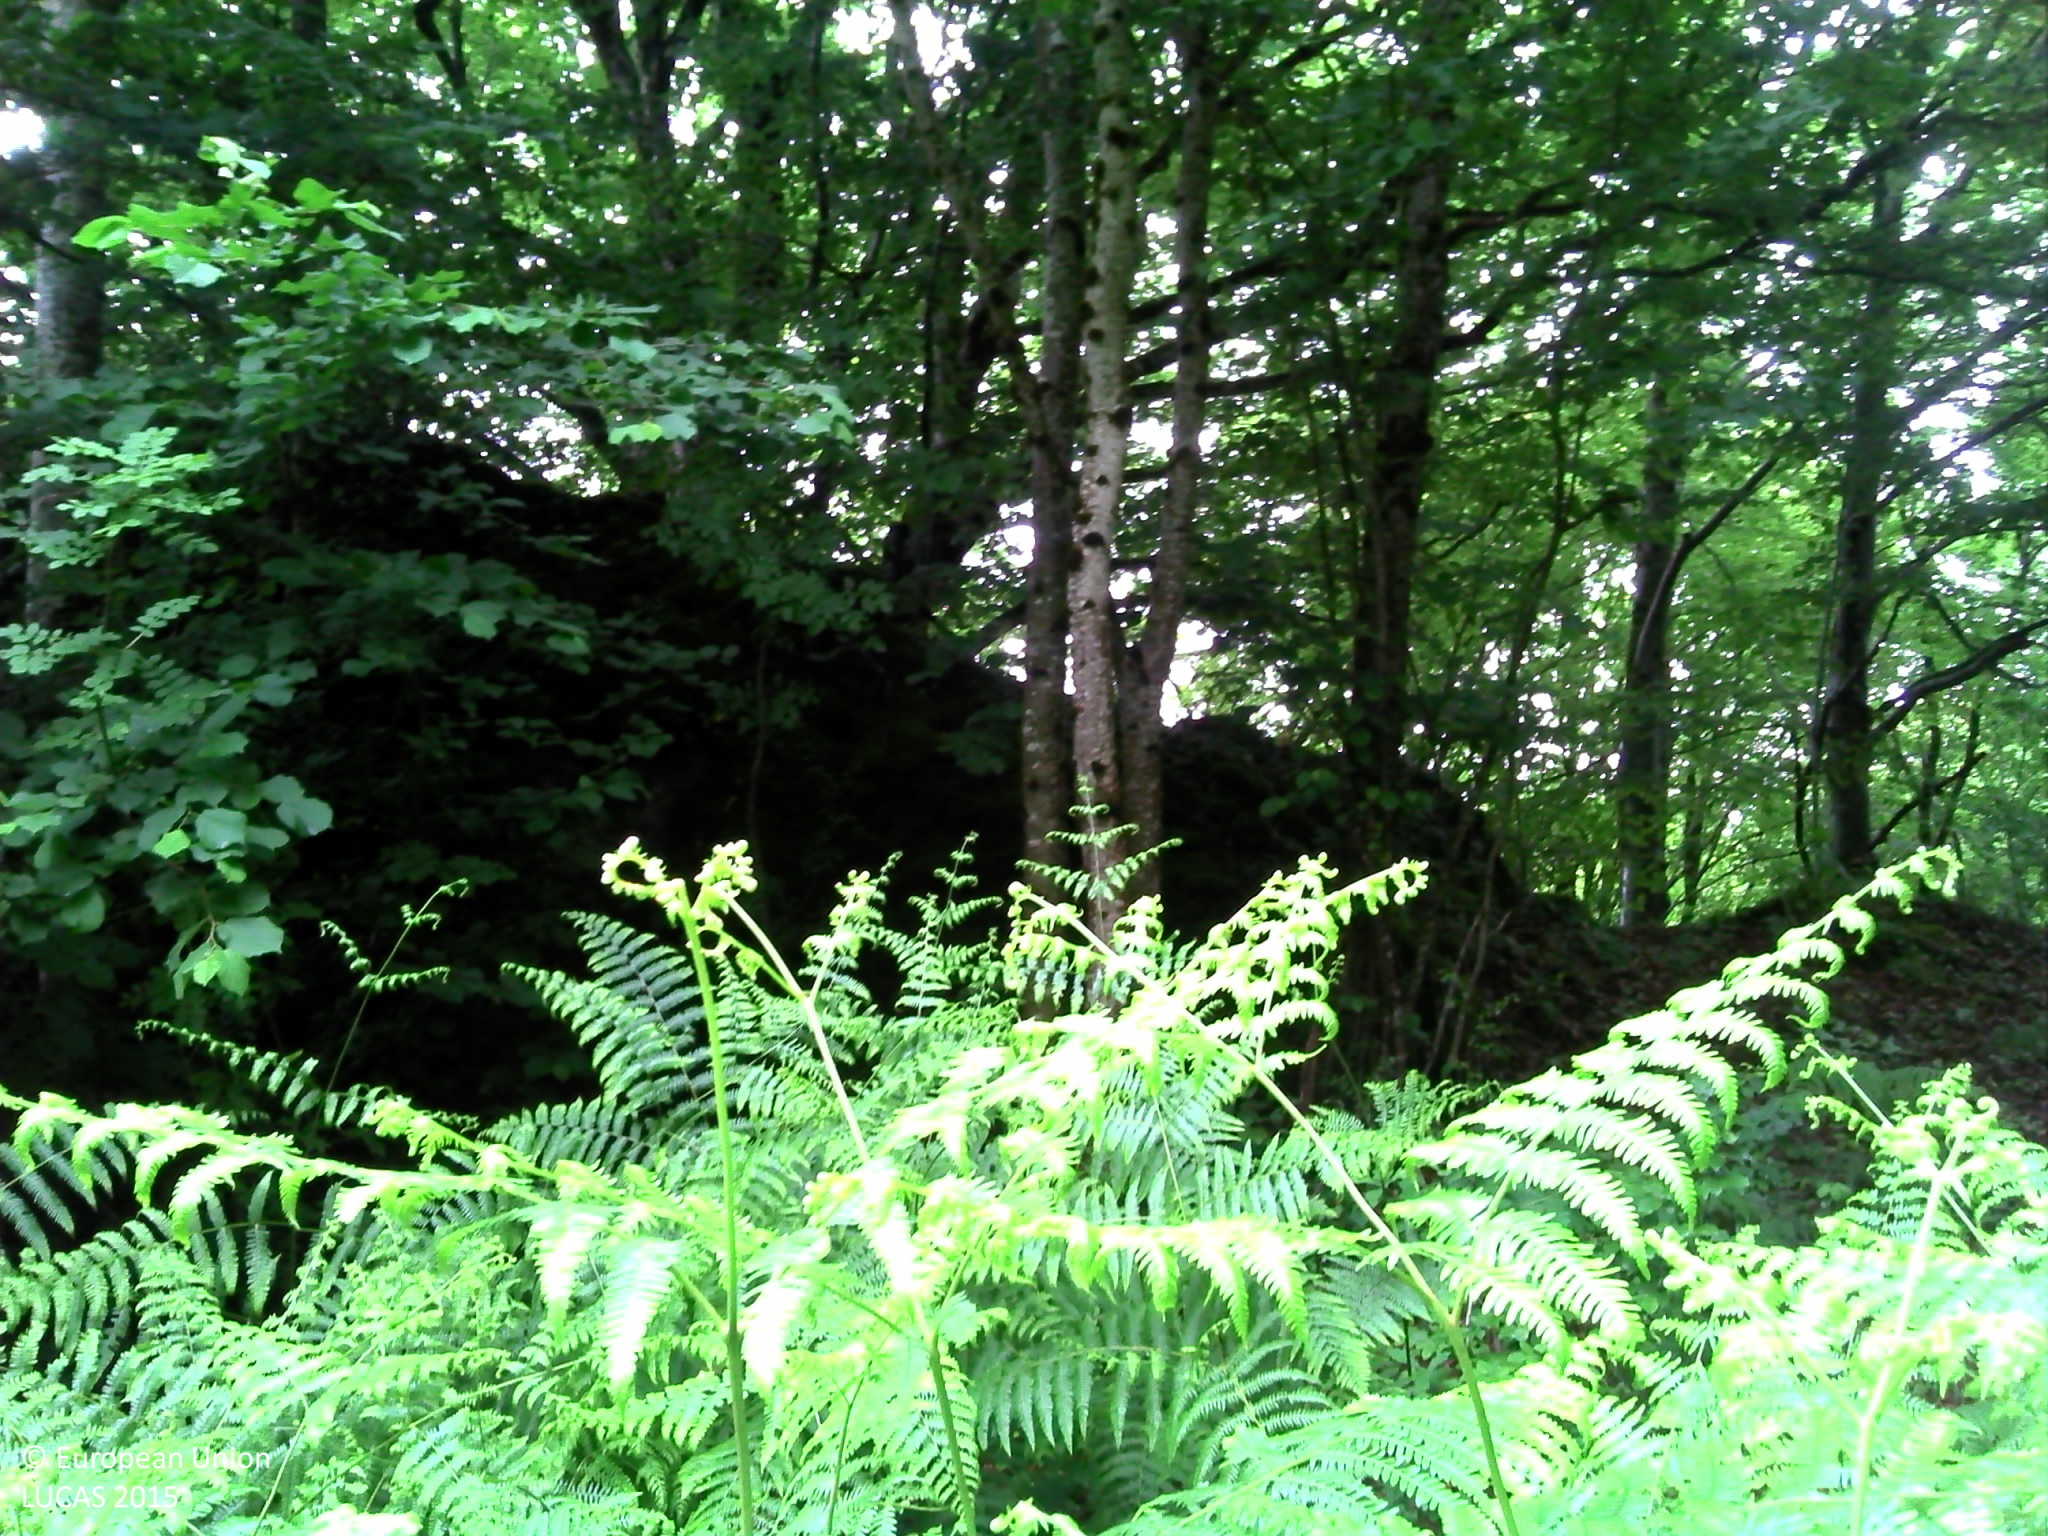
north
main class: Woodland
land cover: Broadleaved woodland
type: acidophilous oak and oak-birch forest
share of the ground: > 75 %
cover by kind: broadleaved forest trees 75 %, shrubs 20 %, herbaceous plants 5 %
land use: Semi-natural and natural areas not in use
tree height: > 5 m
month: June
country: FR
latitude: 45.0024
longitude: 2.5028
